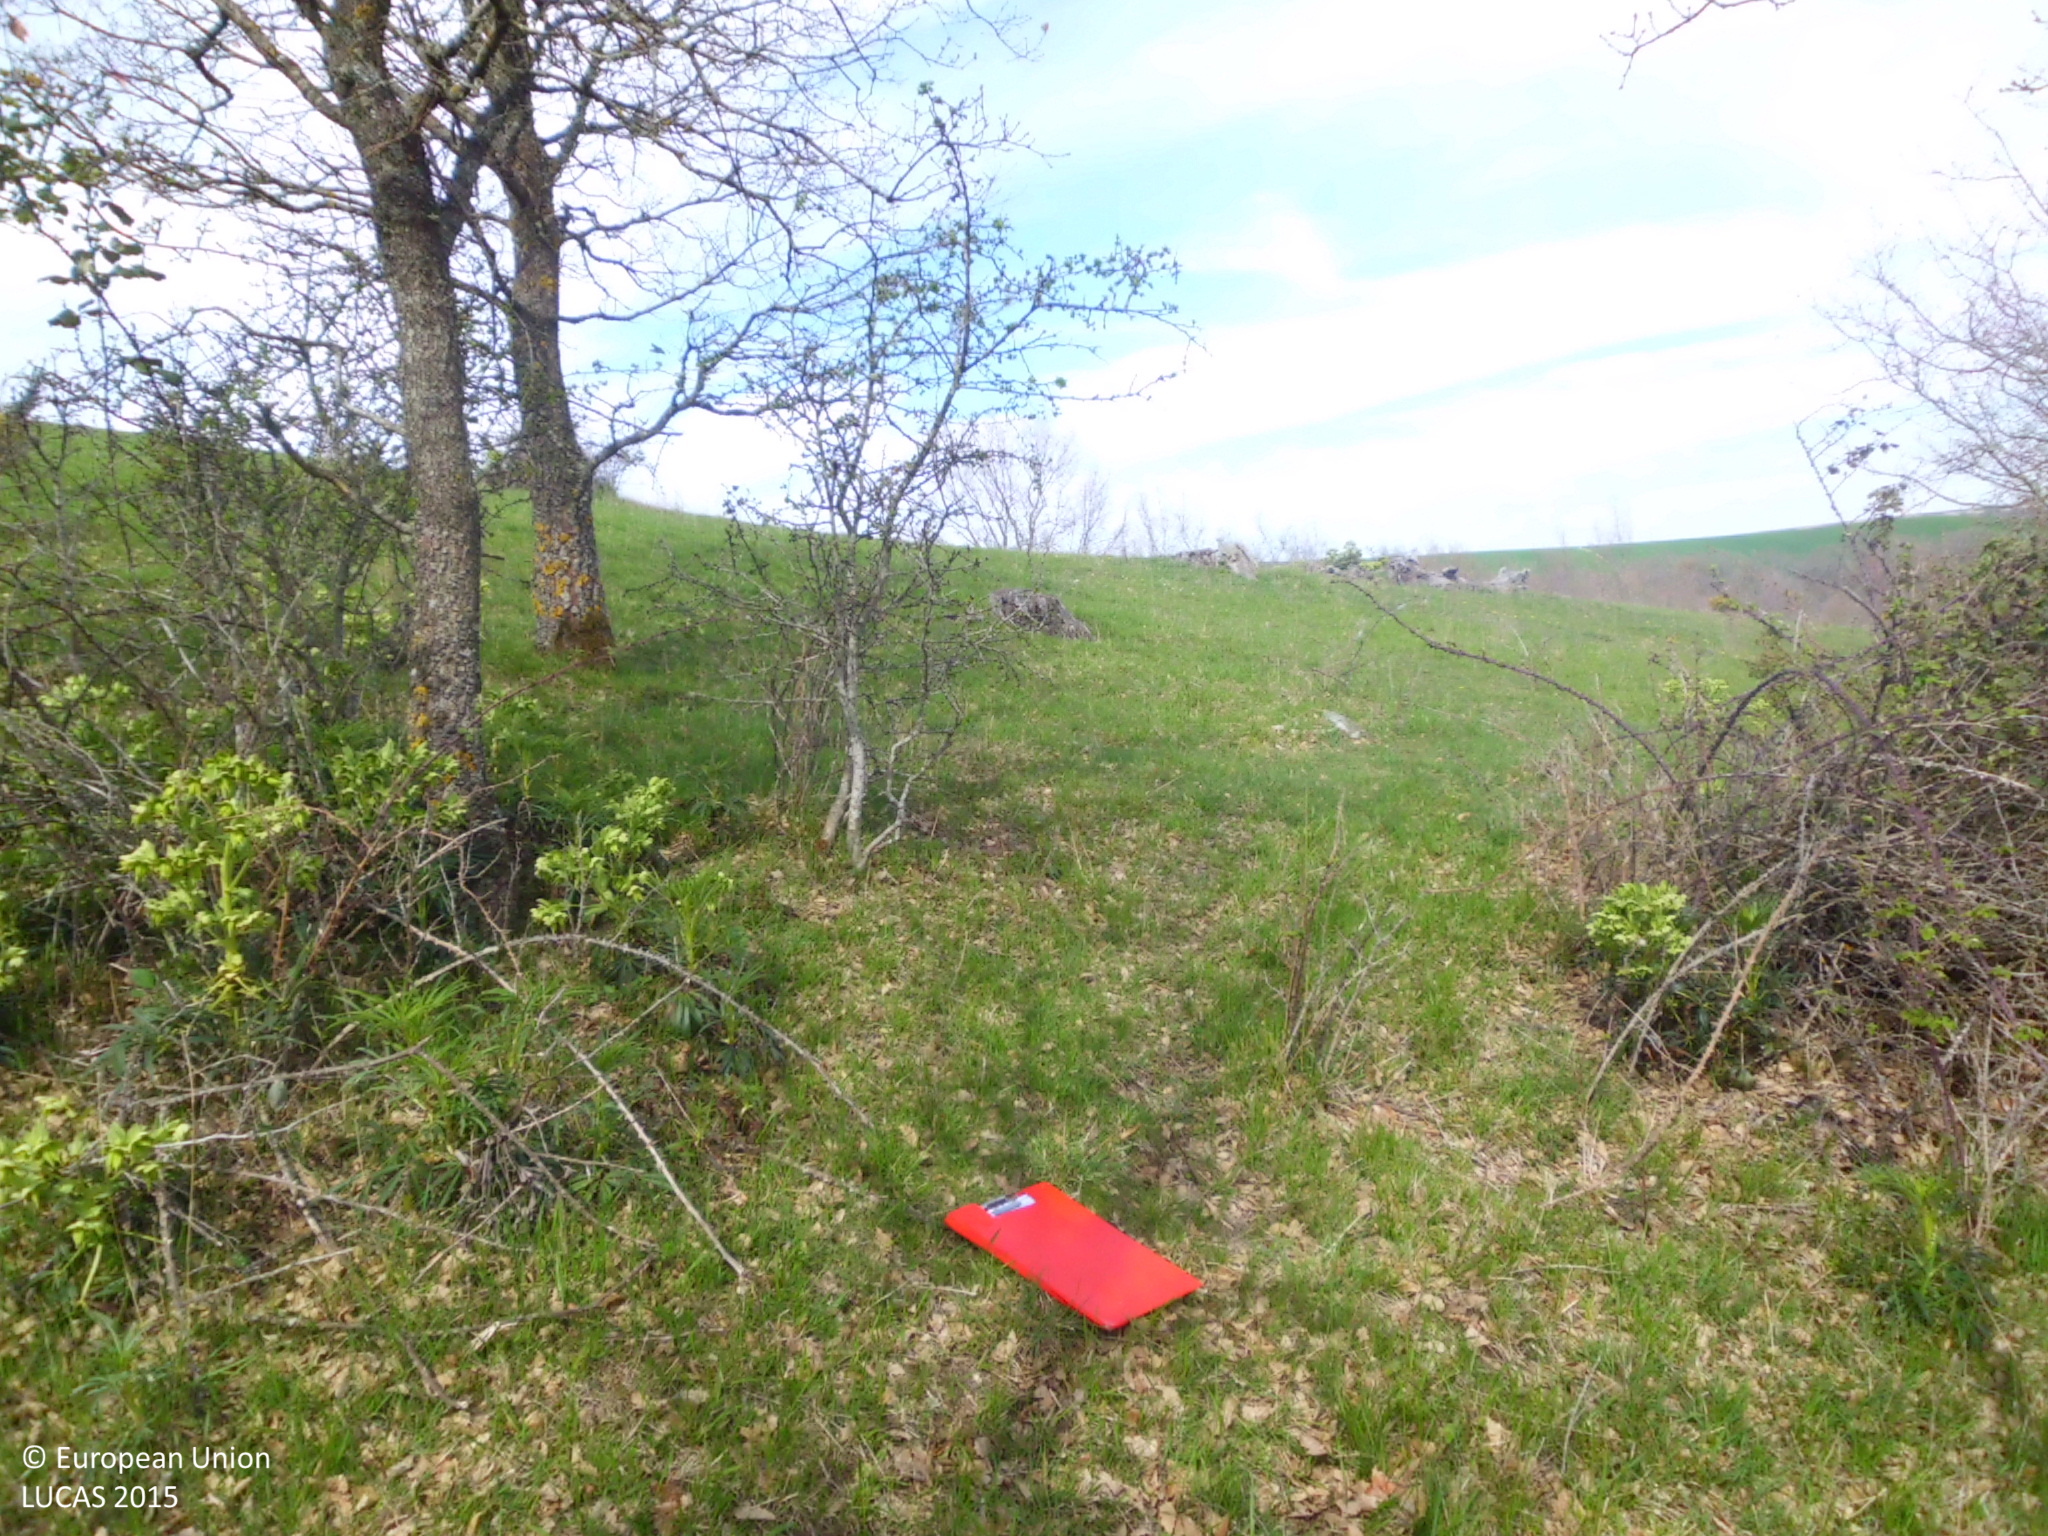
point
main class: Woodland
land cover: Broadleaved woodland
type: acidophilous oak and oak-birch forest
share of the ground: 25 - 50 %
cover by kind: herbaceous plants 55 %, broadleaved forest trees 35 %, shrubs 10 %
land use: Abandoned areas
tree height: > 5 m
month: April
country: ES
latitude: 42.4365
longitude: -3.3924
